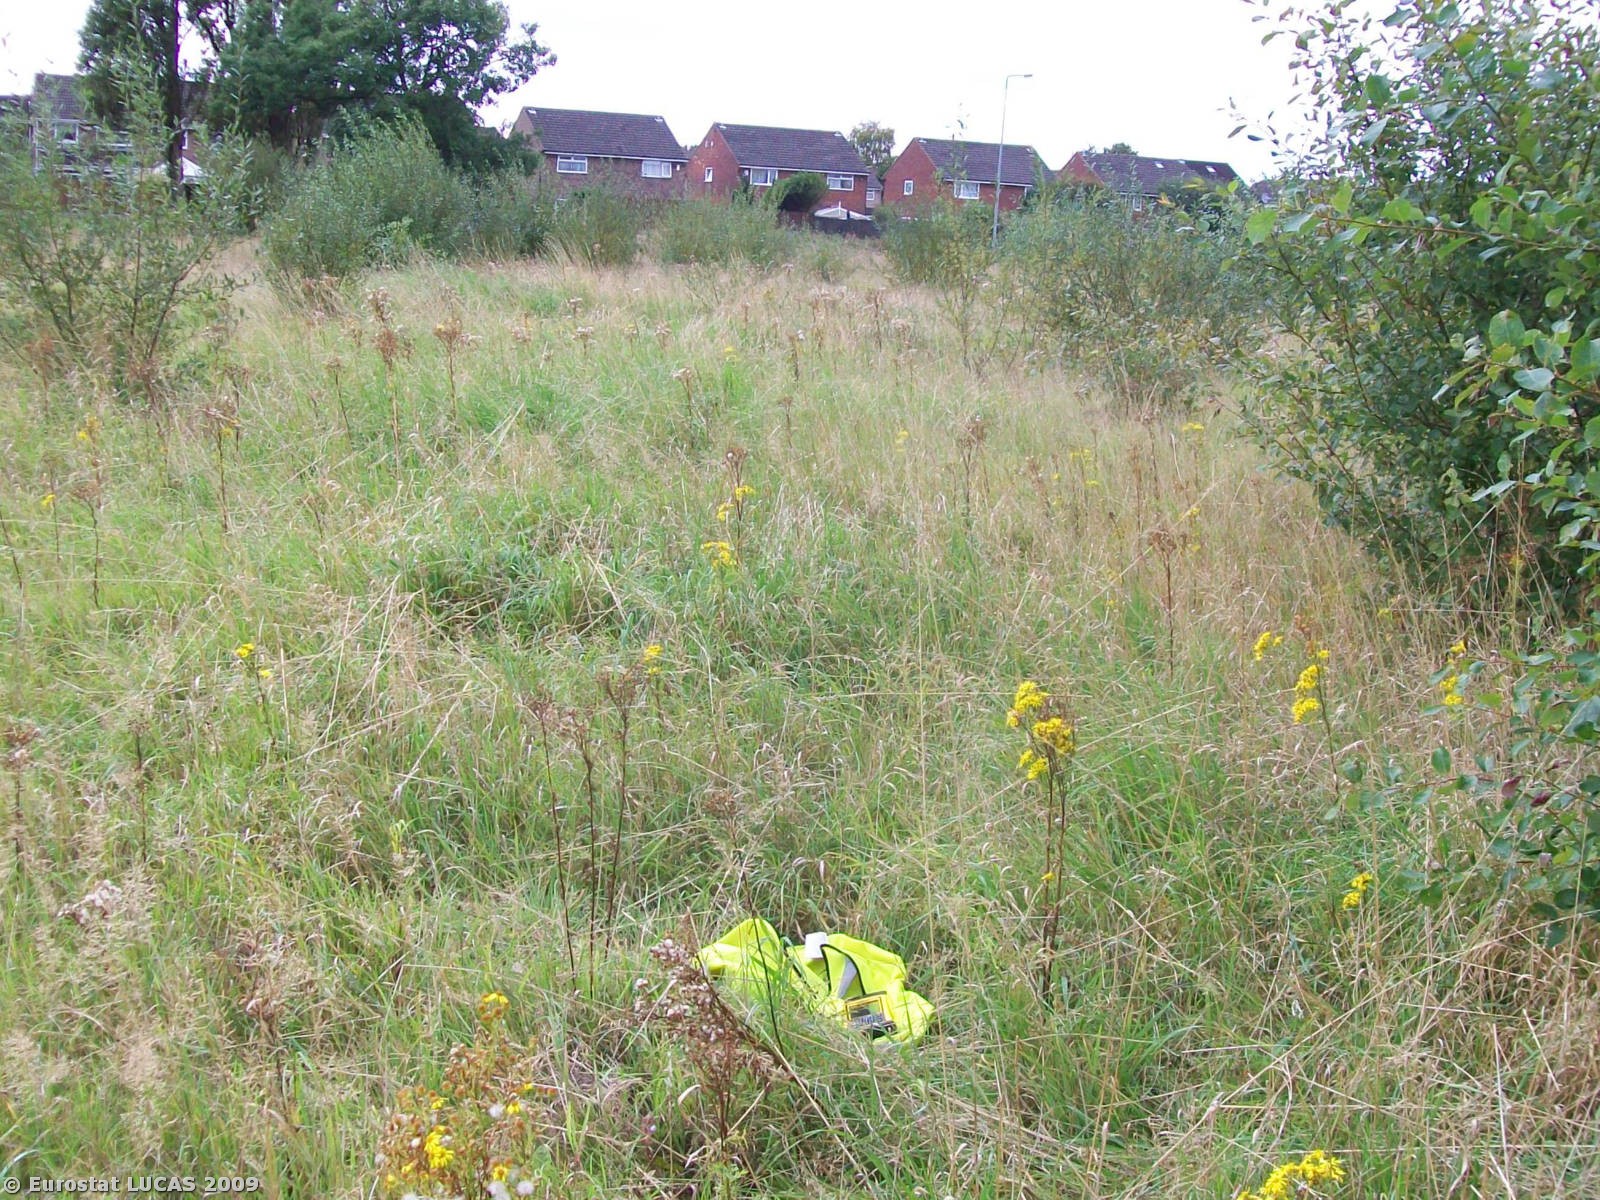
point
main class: Grassland
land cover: Grassland with sparse tree/shrub cover
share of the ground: 10 - 25 %
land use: Unused
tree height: > 5 m
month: September
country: GB
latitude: 53.3714
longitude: -2.8318
